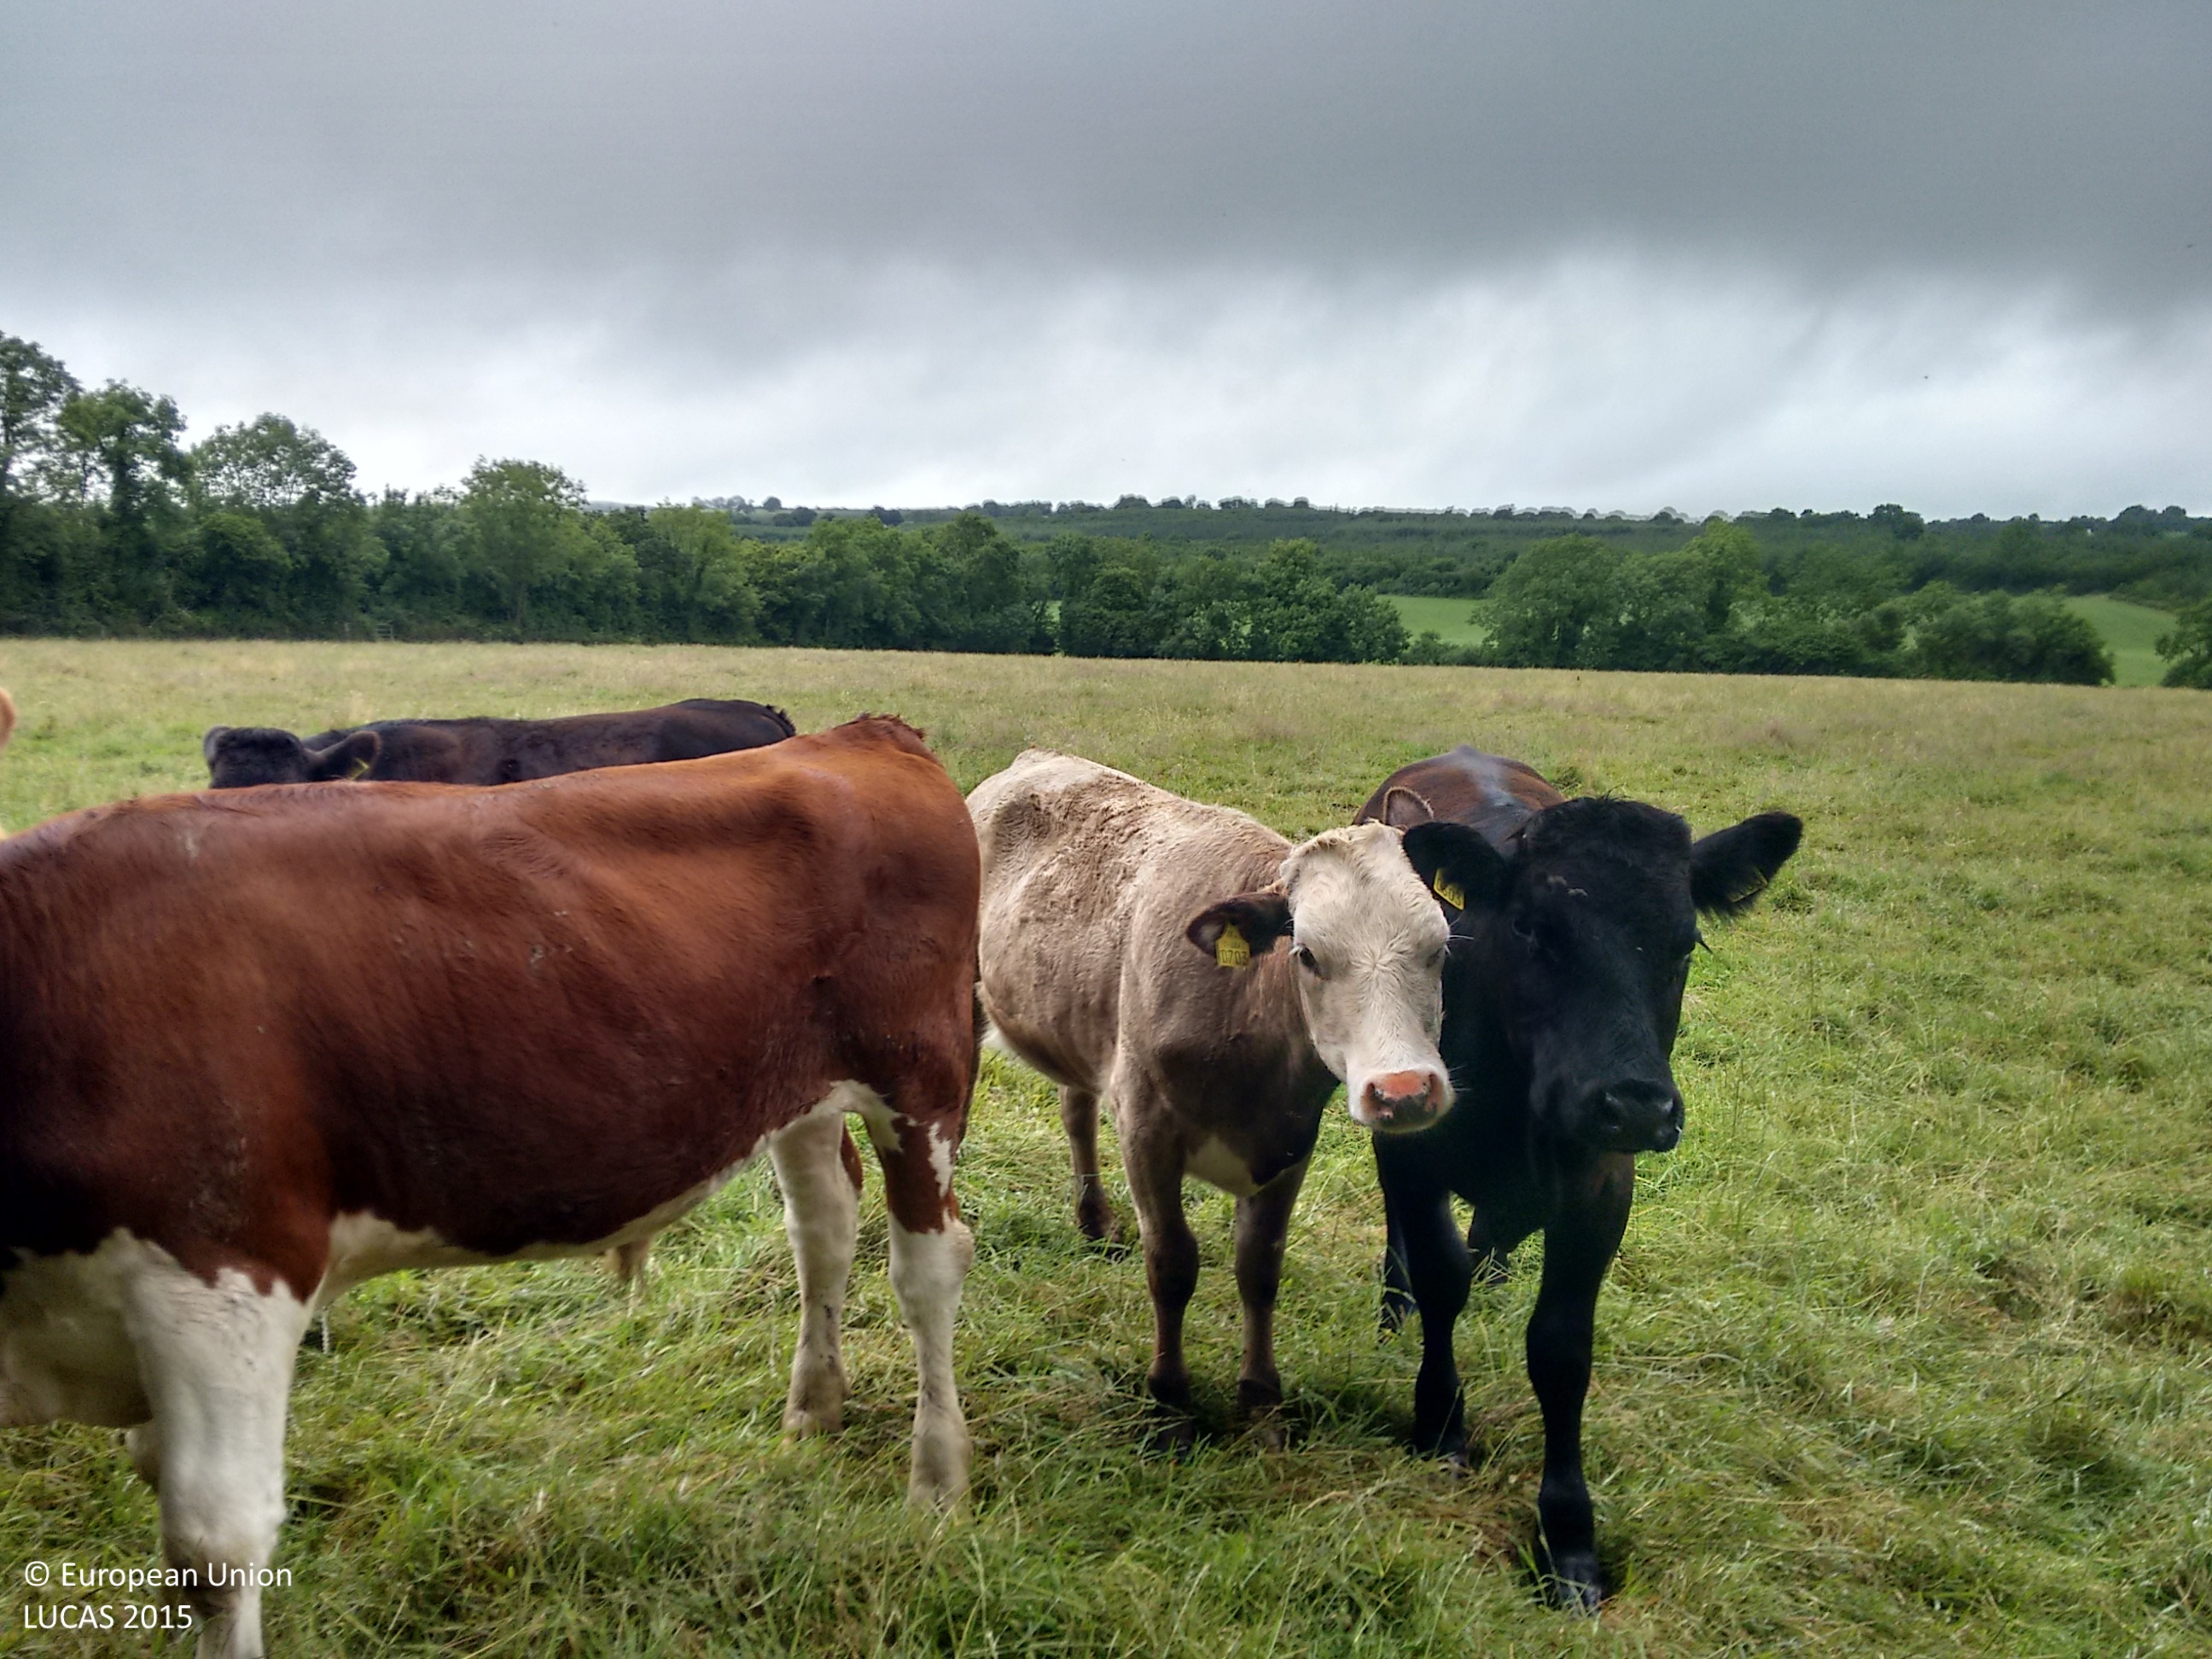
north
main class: Grassland
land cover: Grassland without tree/shrub cover
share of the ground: > 75 %
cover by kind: herbaceous plants 100 %
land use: Agriculture (excluding fallow land and kitchen gardens)
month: July
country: IE
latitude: 52.6171
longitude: -7.4532
